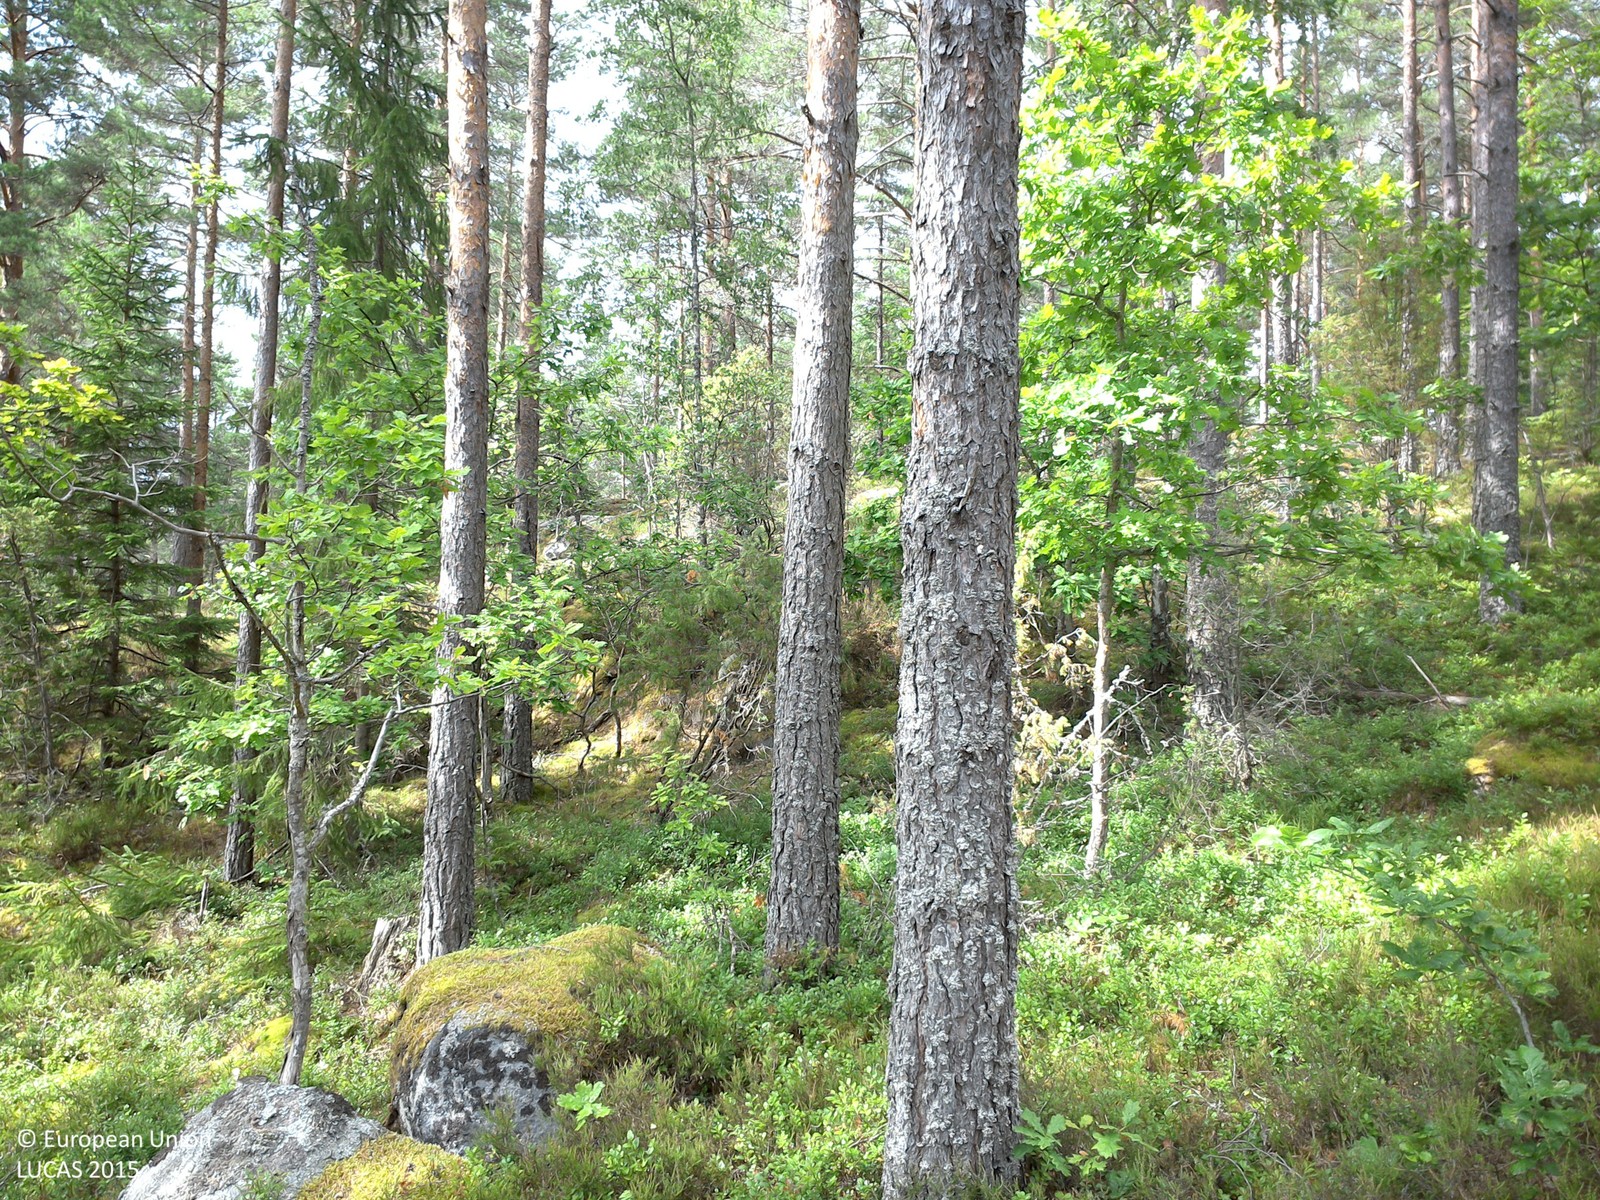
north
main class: Woodland
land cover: Pine dominated coniferous woodland
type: boreal forest
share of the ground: 50 - 75 %
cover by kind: coniferous forest trees 60 %, herbaceous plants 30 %, lichens and mosses 10 %
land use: Forestry
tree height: > 5 m
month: July
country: SE
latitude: 57.7400
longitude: 16.0613
